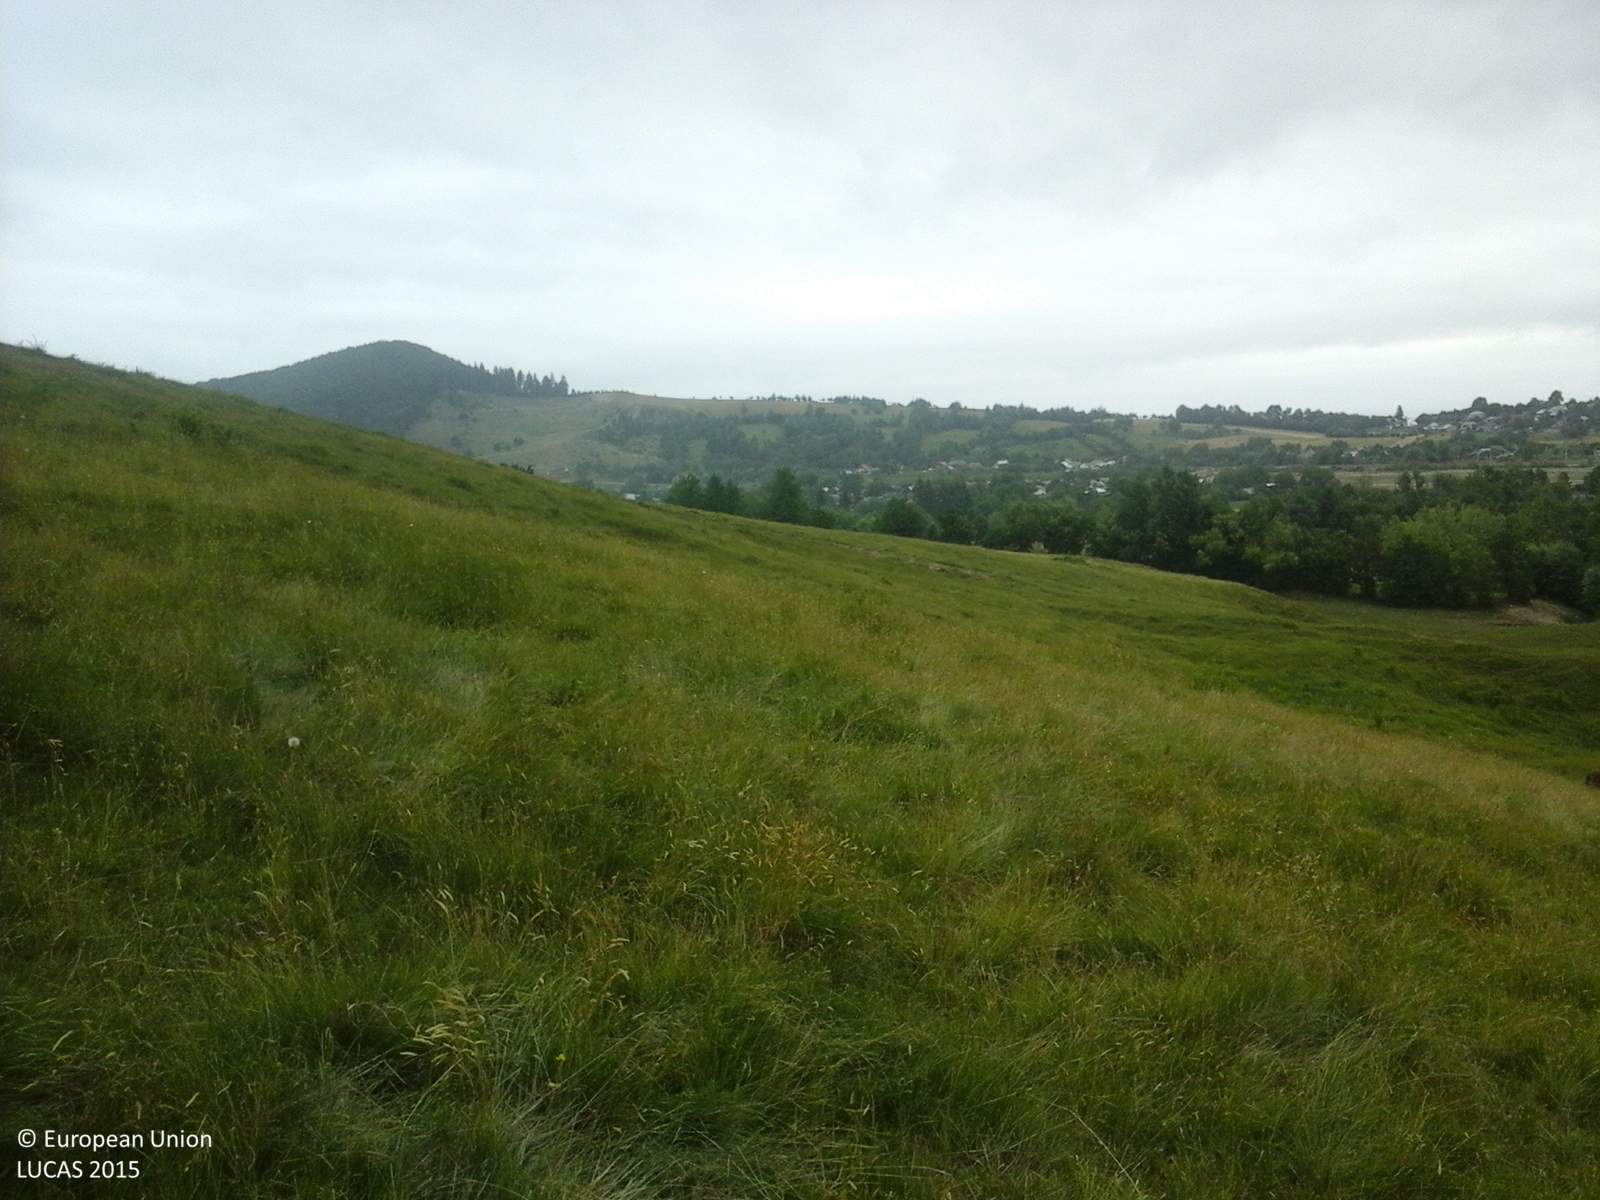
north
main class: Grassland
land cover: Grassland without tree/shrub cover
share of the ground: > 75 %
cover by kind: herbaceous plants 100 %
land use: Agriculture (excluding fallow land and kitchen gardens)
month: June
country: RO
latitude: 47.0917
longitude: 26.2975
